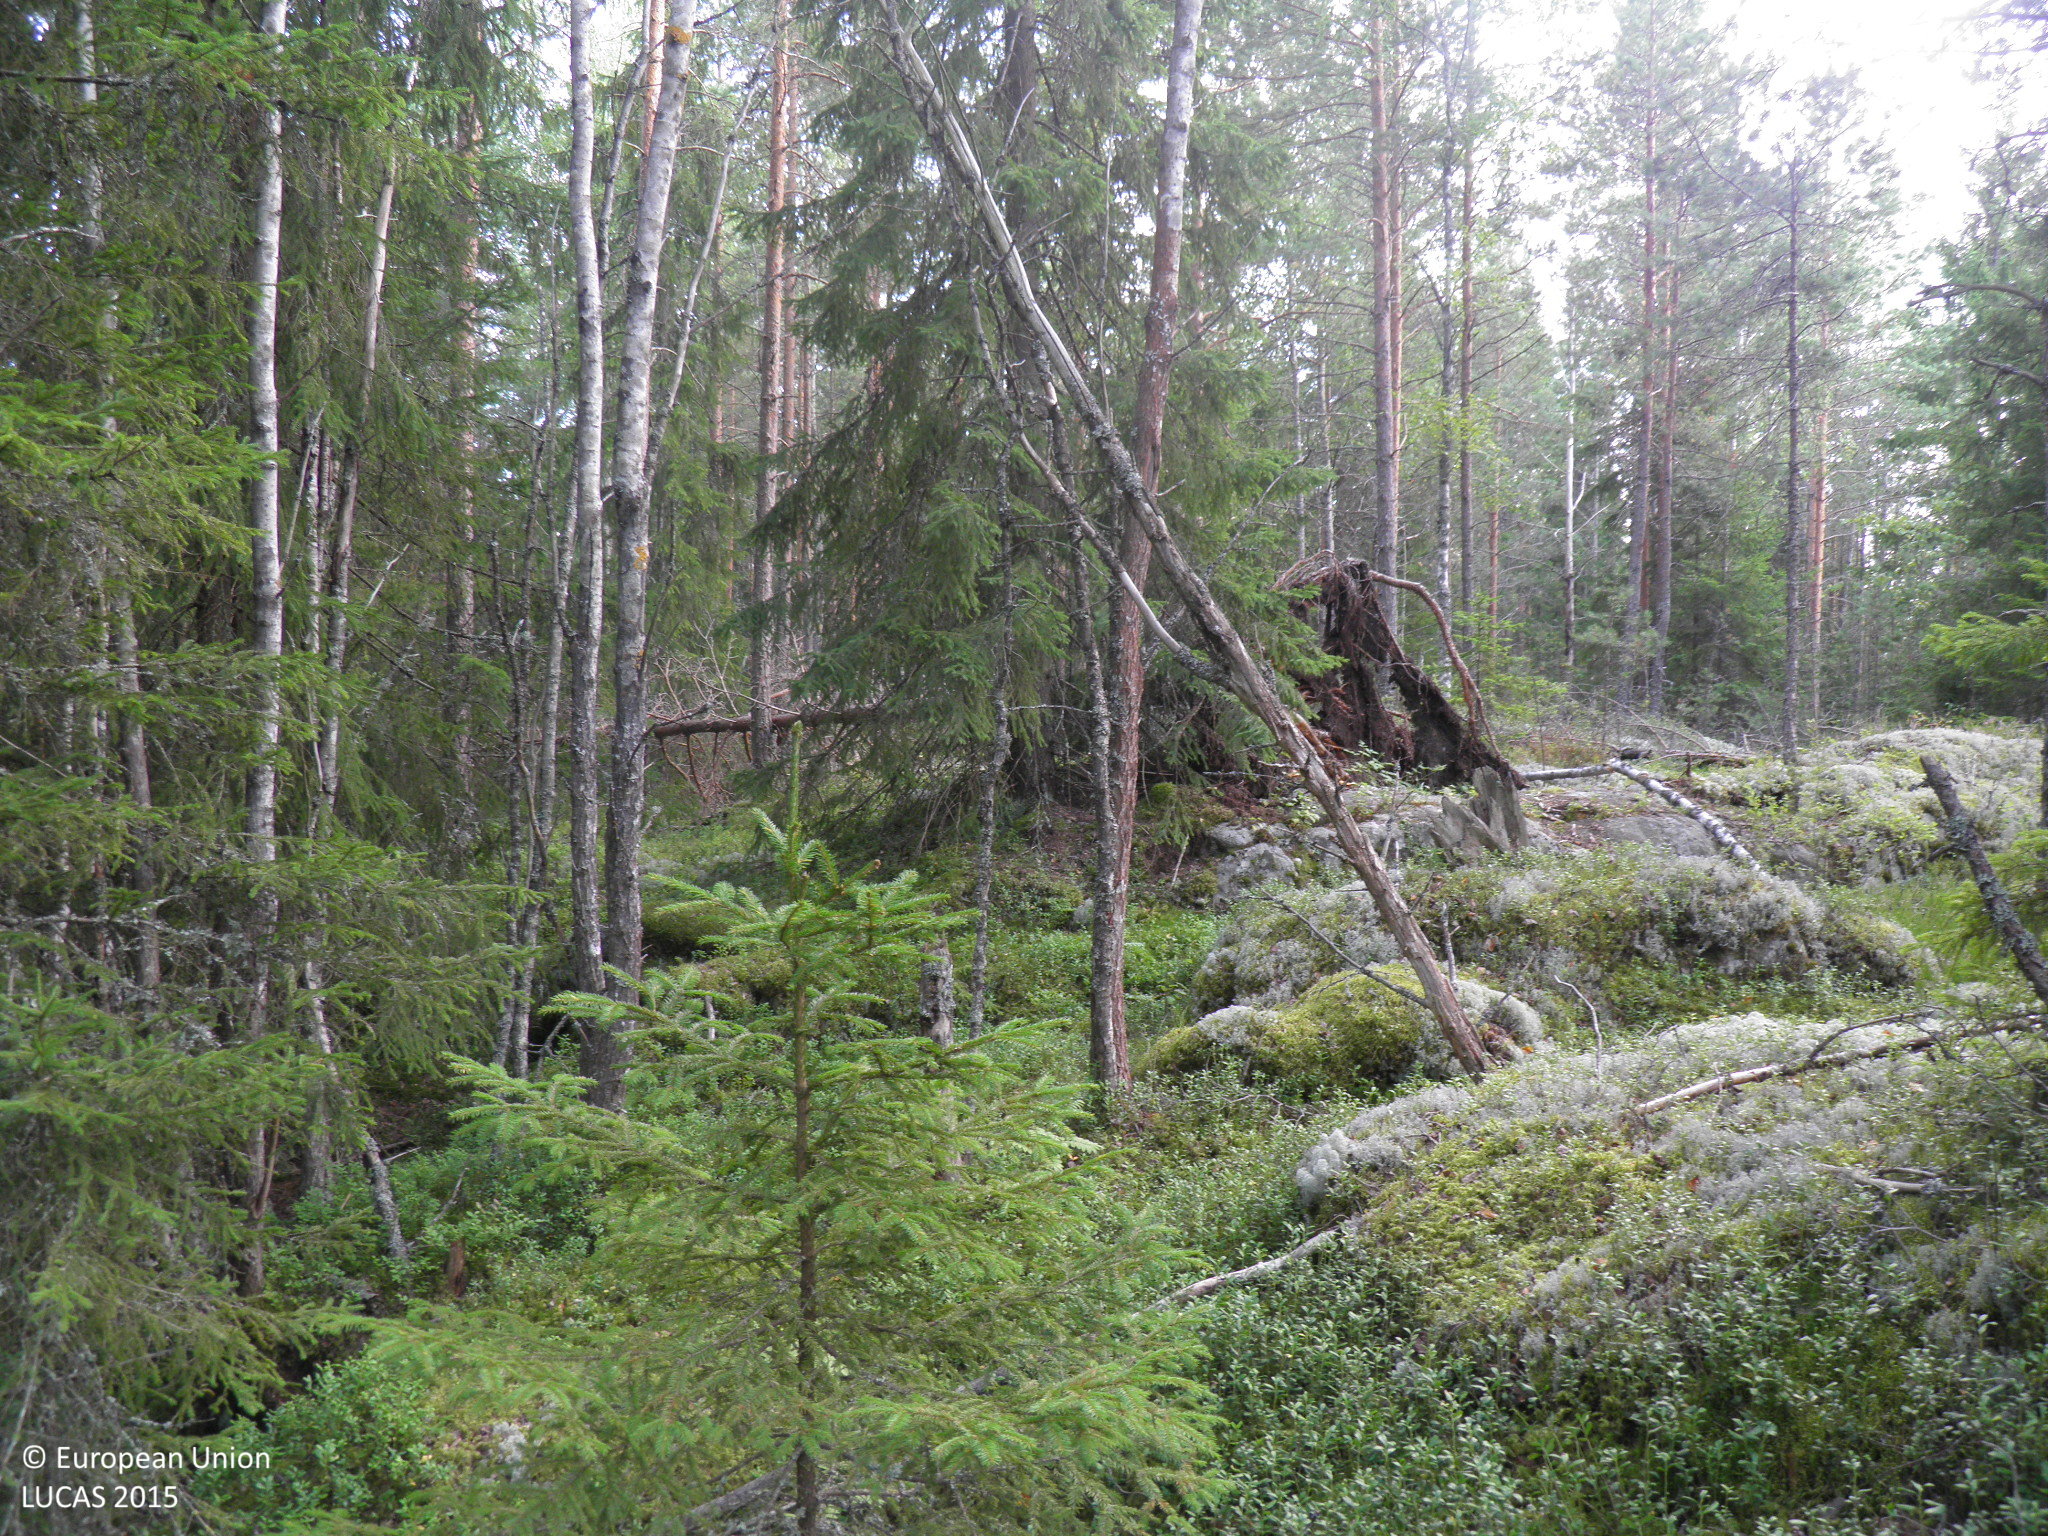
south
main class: Woodland
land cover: Pine dominated mixed woodland
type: hemiboreal forest and nemoral coniferous forest and mixed broadleaved-coniferous forest
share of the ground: 50 - 75 %
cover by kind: coniferous forest trees 30 %, lichens and mosses 30 %, broadleaved forest trees 20 %, shrubs 20 %
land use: Forestry
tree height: > 5 m
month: August
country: FI
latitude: 61.1680
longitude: 22.5773
